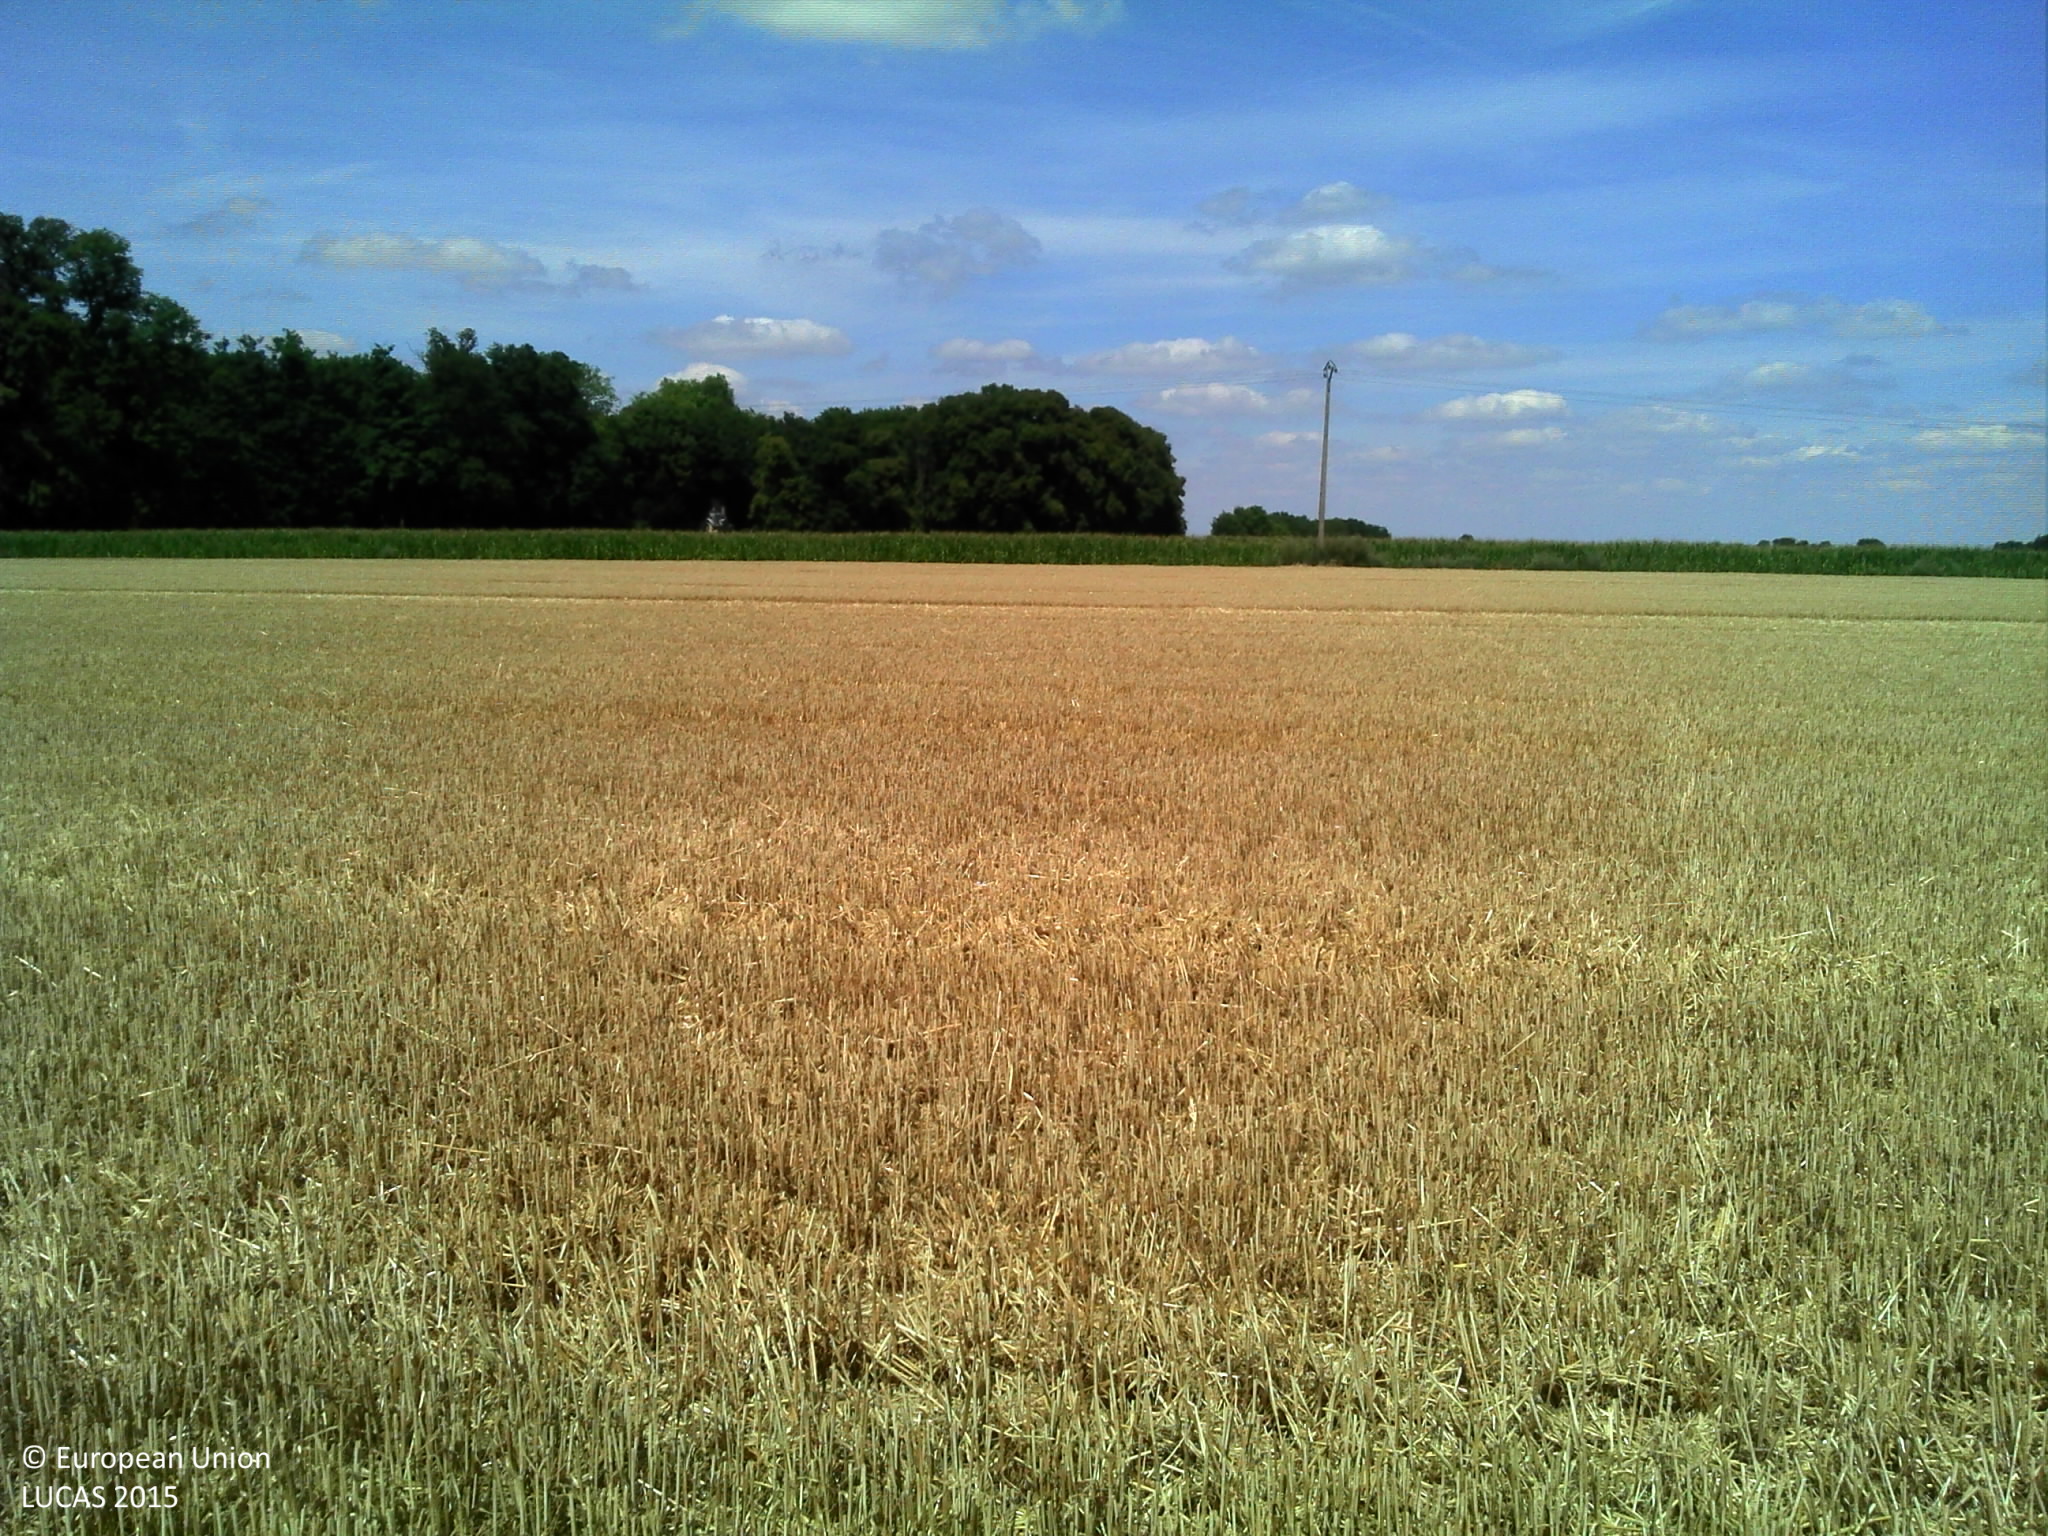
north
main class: Cropland
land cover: Common wheat
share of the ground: > 75 %
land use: Agriculture (excluding fallow land and kitchen gardens)
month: July
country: FR
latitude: 49.0825
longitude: 2.4166
